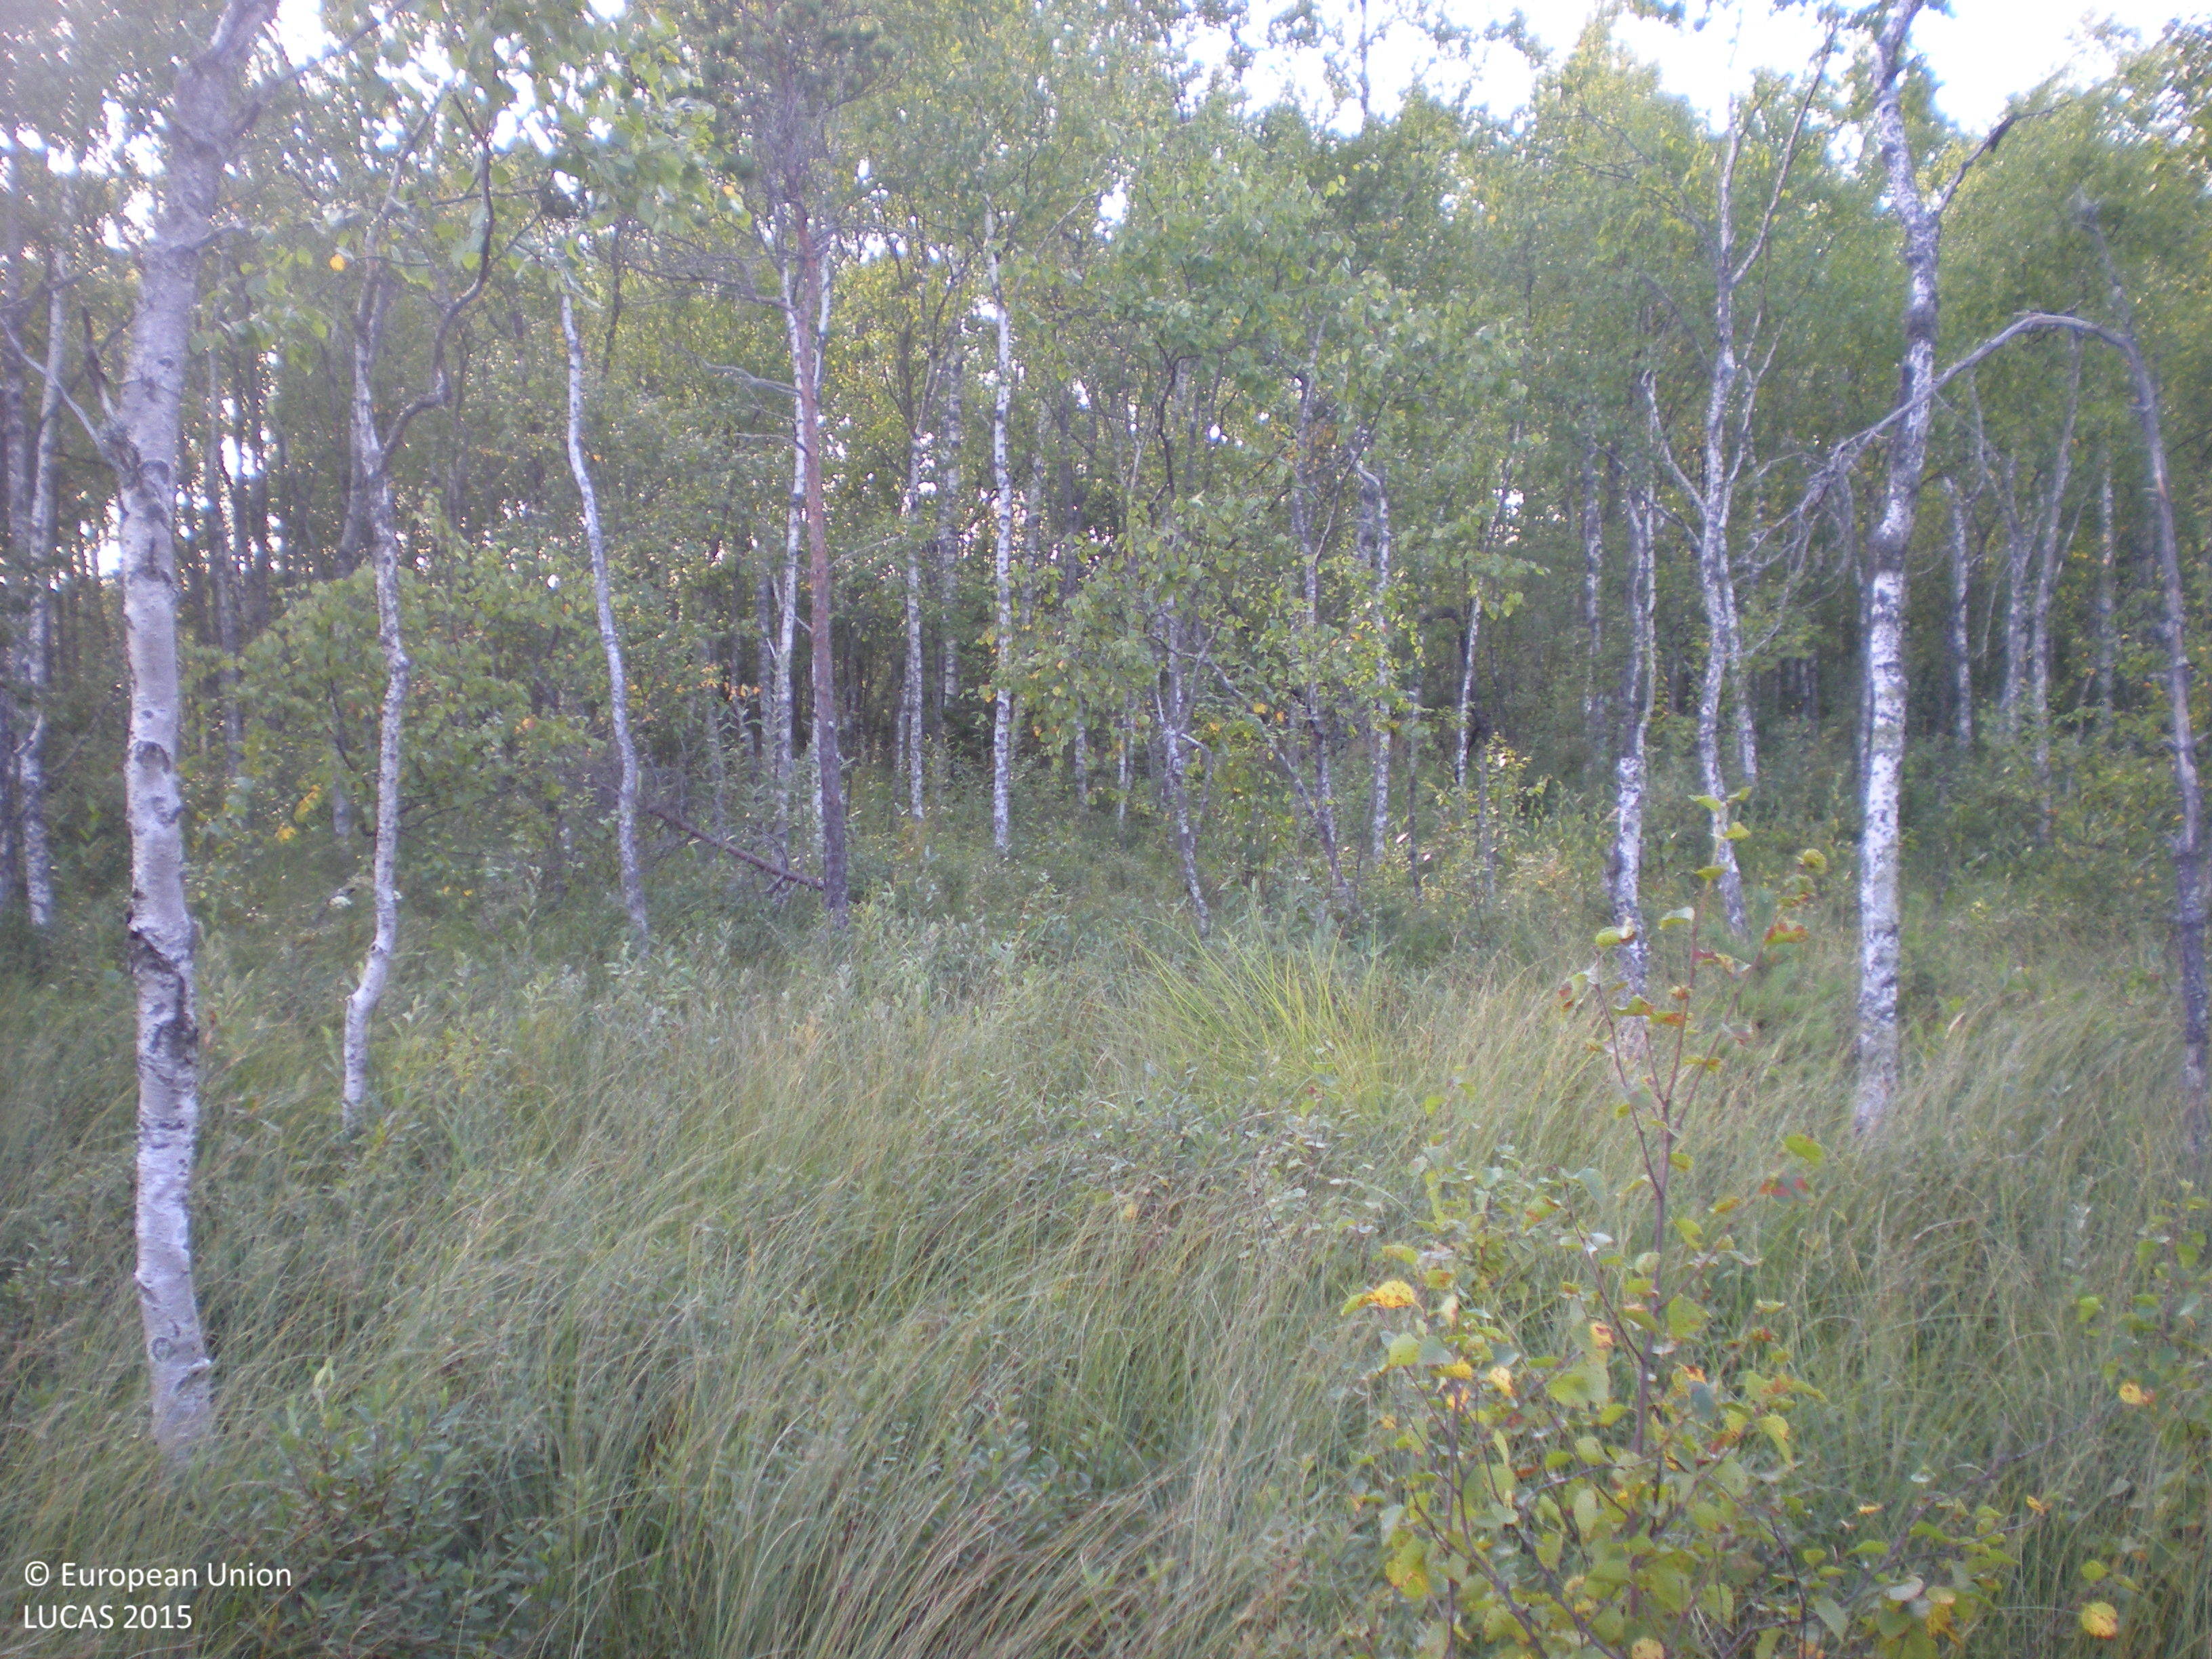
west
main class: Woodland
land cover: Broadleaved woodland
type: mire and swamp forests
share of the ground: > 75 %
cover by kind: herbaceous plants 70 %, broadleaved forest trees 15 %, shrubs 15 %
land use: Semi-natural and natural areas not in use
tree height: < 5 m
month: August
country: SE
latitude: 60.5453
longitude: 17.0813
